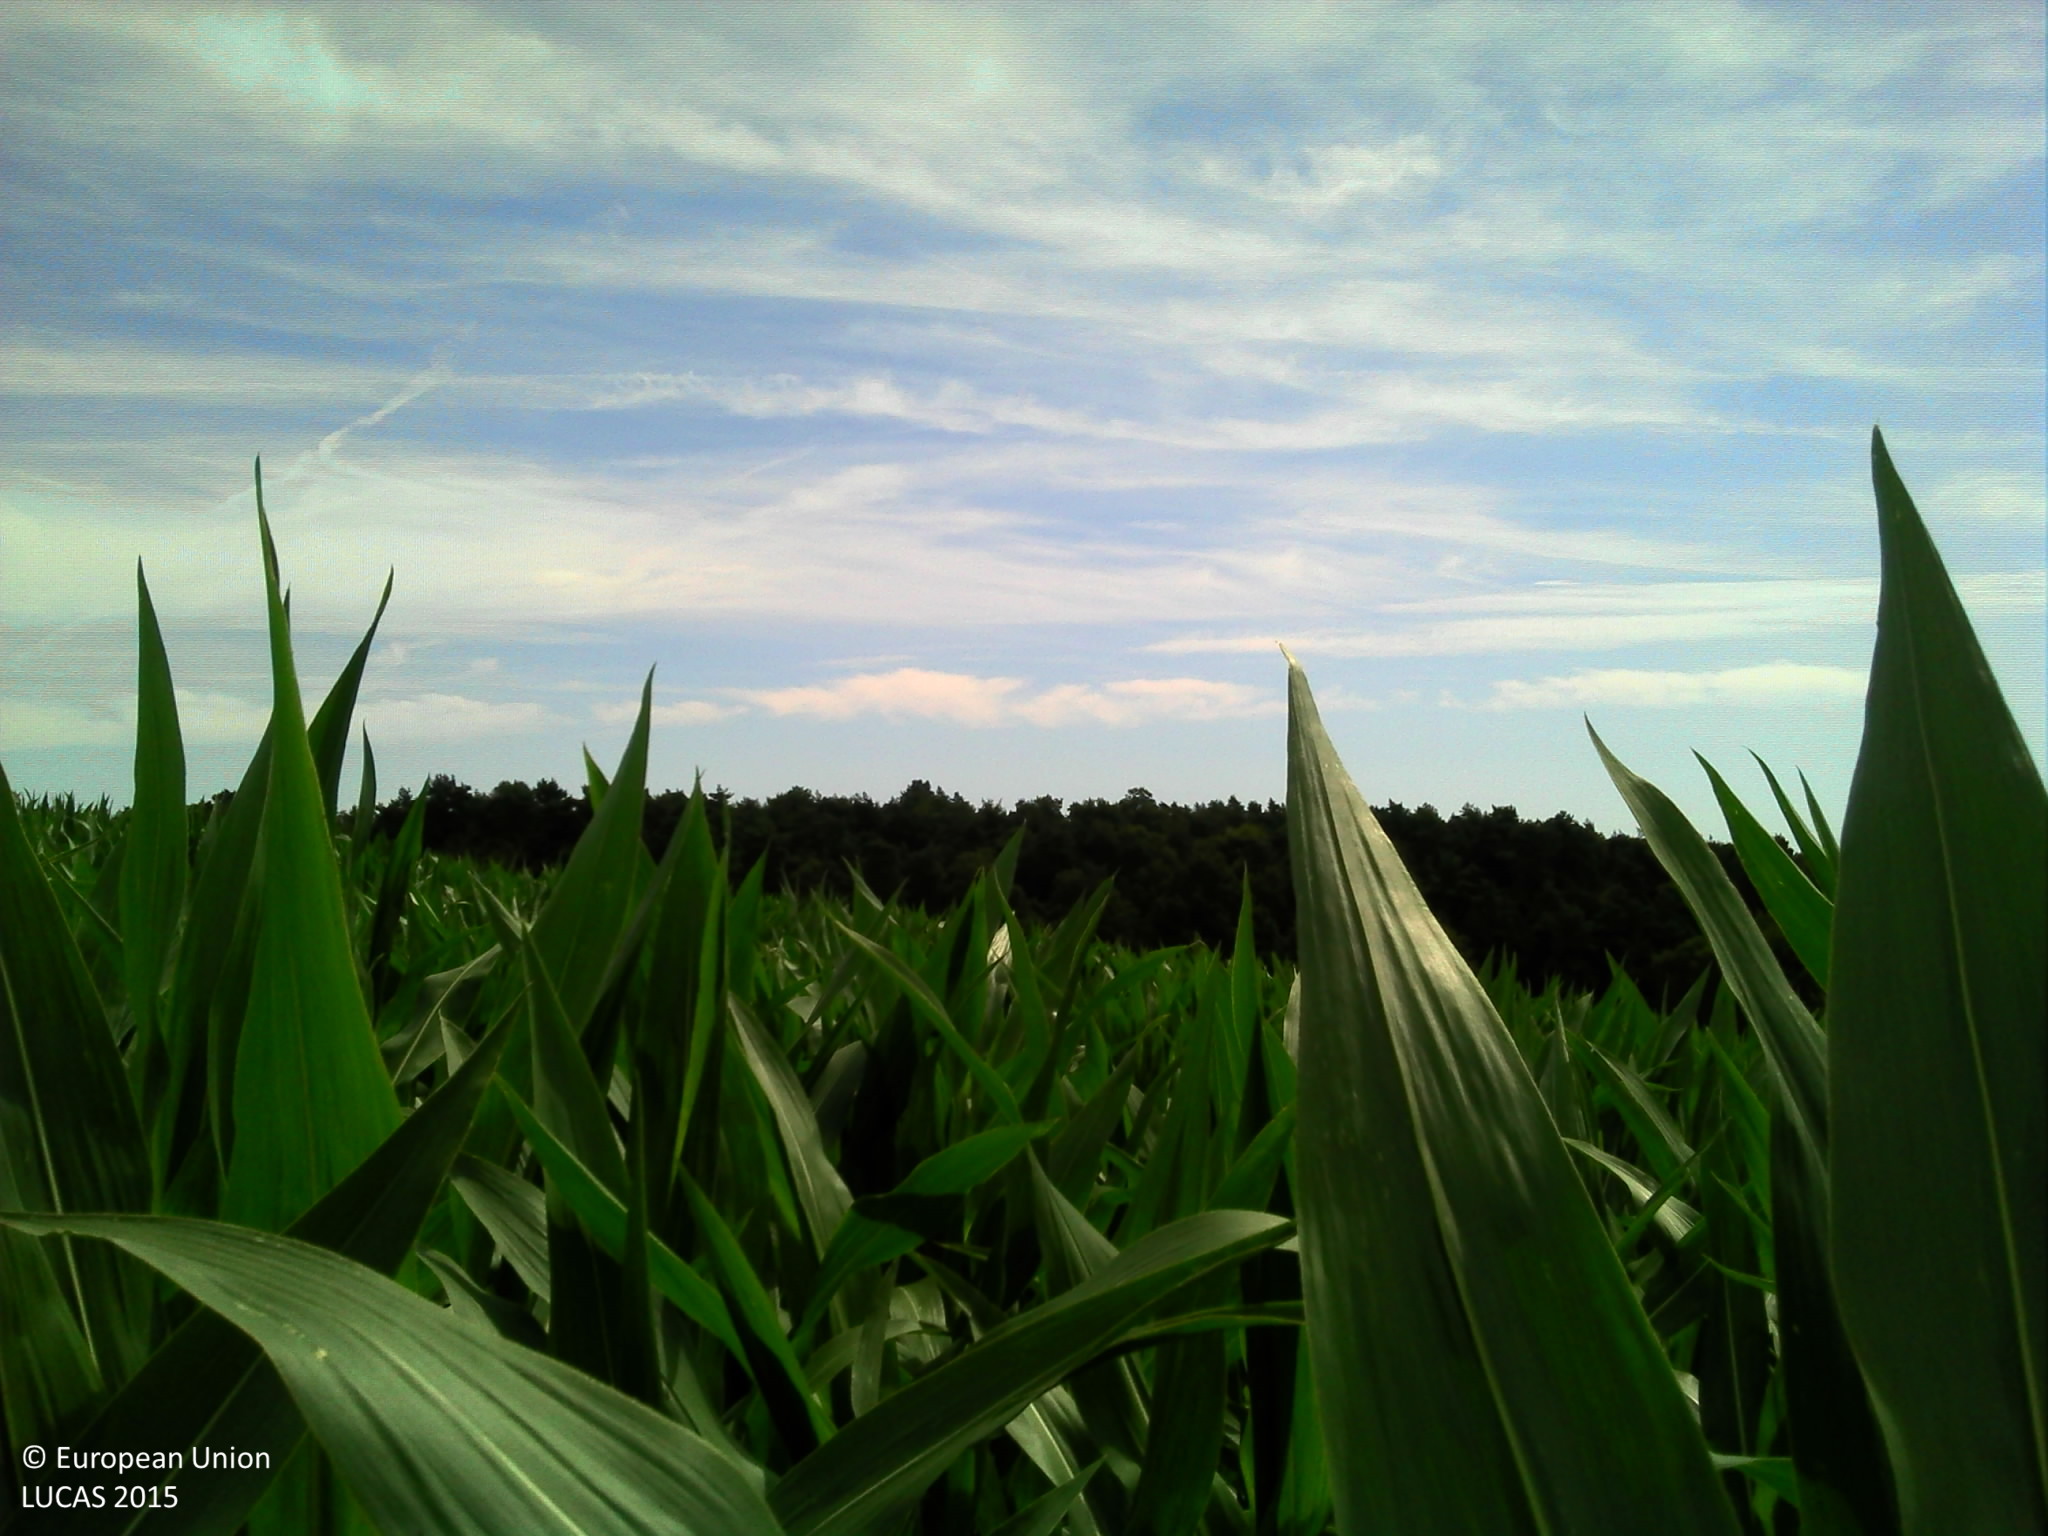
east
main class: Cropland
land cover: Maize
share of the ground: > 75 %
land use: Agriculture (excluding fallow land and kitchen gardens)
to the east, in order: Maize; Grassland without tree/shrub cover; Fences; Grass margins; Ditches and canals; Paved roads, cycling and walking lanes; Grass margins; Fences; Grass margins; Durum wheat; Grass margins; Fences; Pine dominated mixed woodland; Tracks; Pine dominated mixed woodland
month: July
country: FR
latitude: 44.7961
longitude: 2.4036
